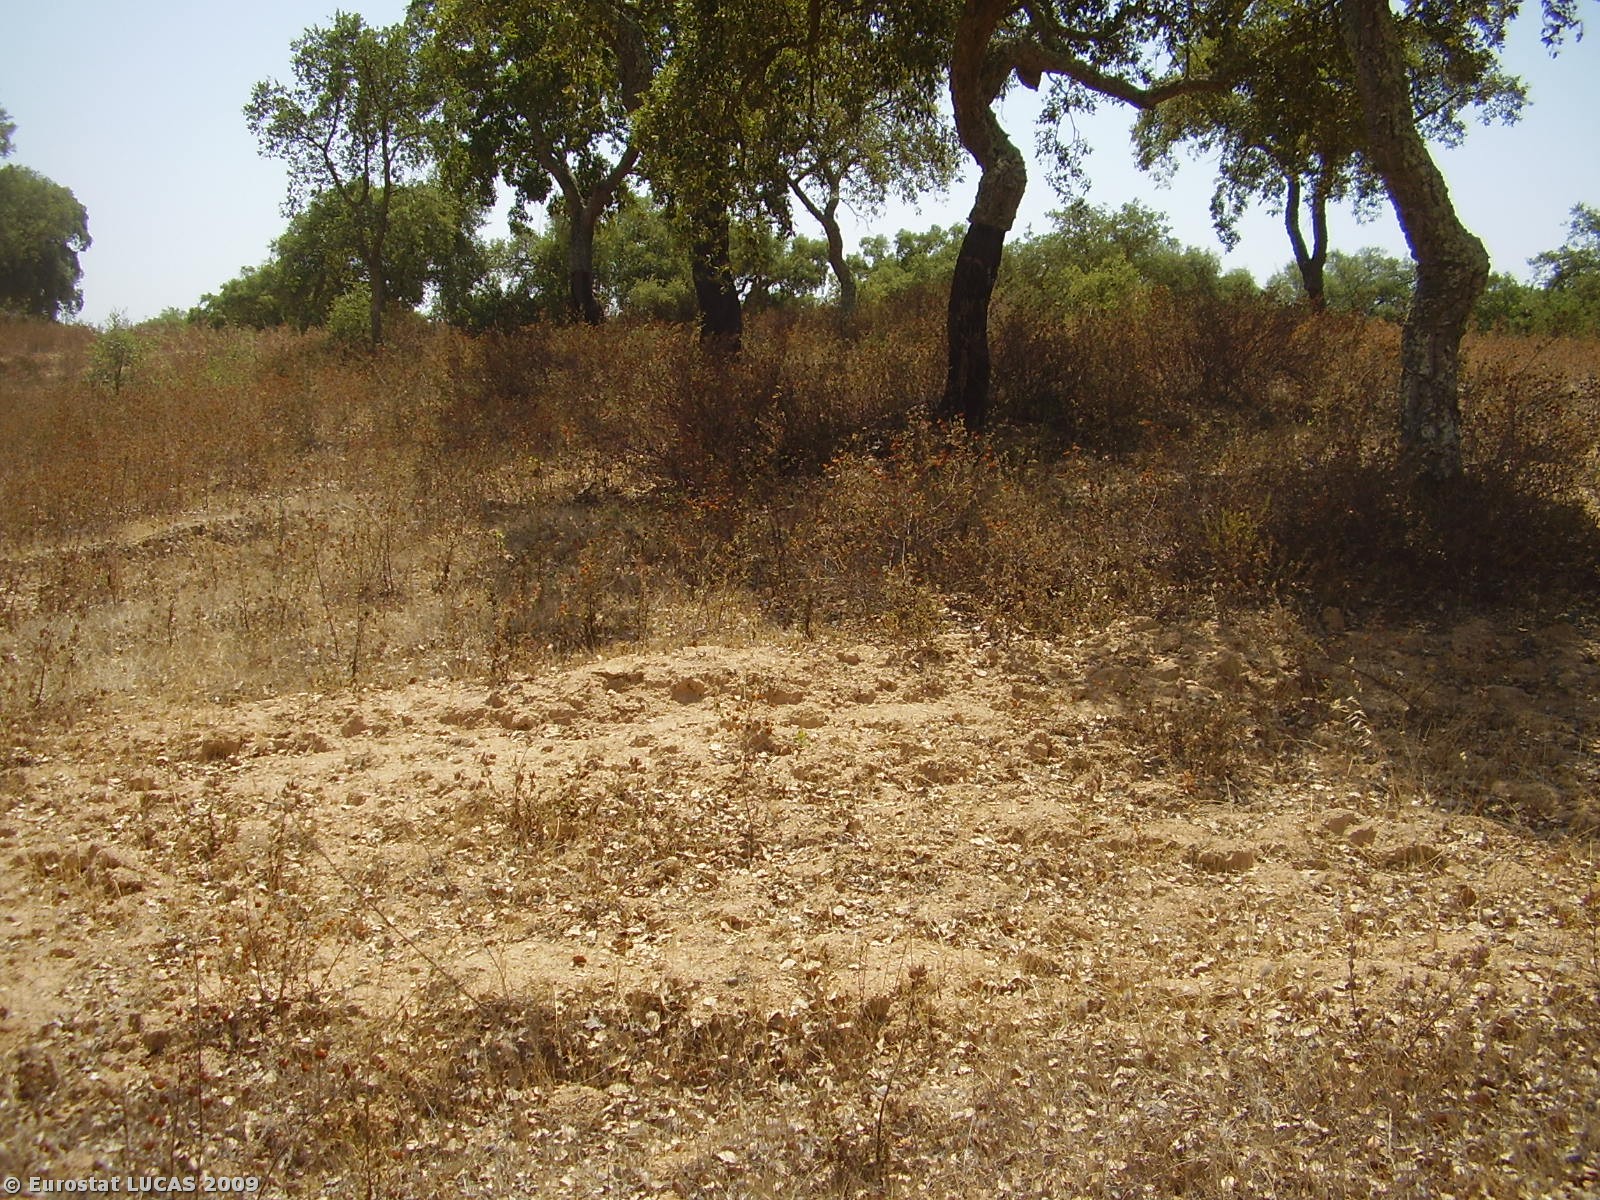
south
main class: Woodland
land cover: Broadleaved woodland
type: broadleaved evergreen forest
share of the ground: 25 - 50 %
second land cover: Shrubland with sparse tree cover
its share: 10 - 25 %
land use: Forestry
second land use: Fallow land
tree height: > 5 m
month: August
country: PT
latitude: 38.2071
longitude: -7.8583
